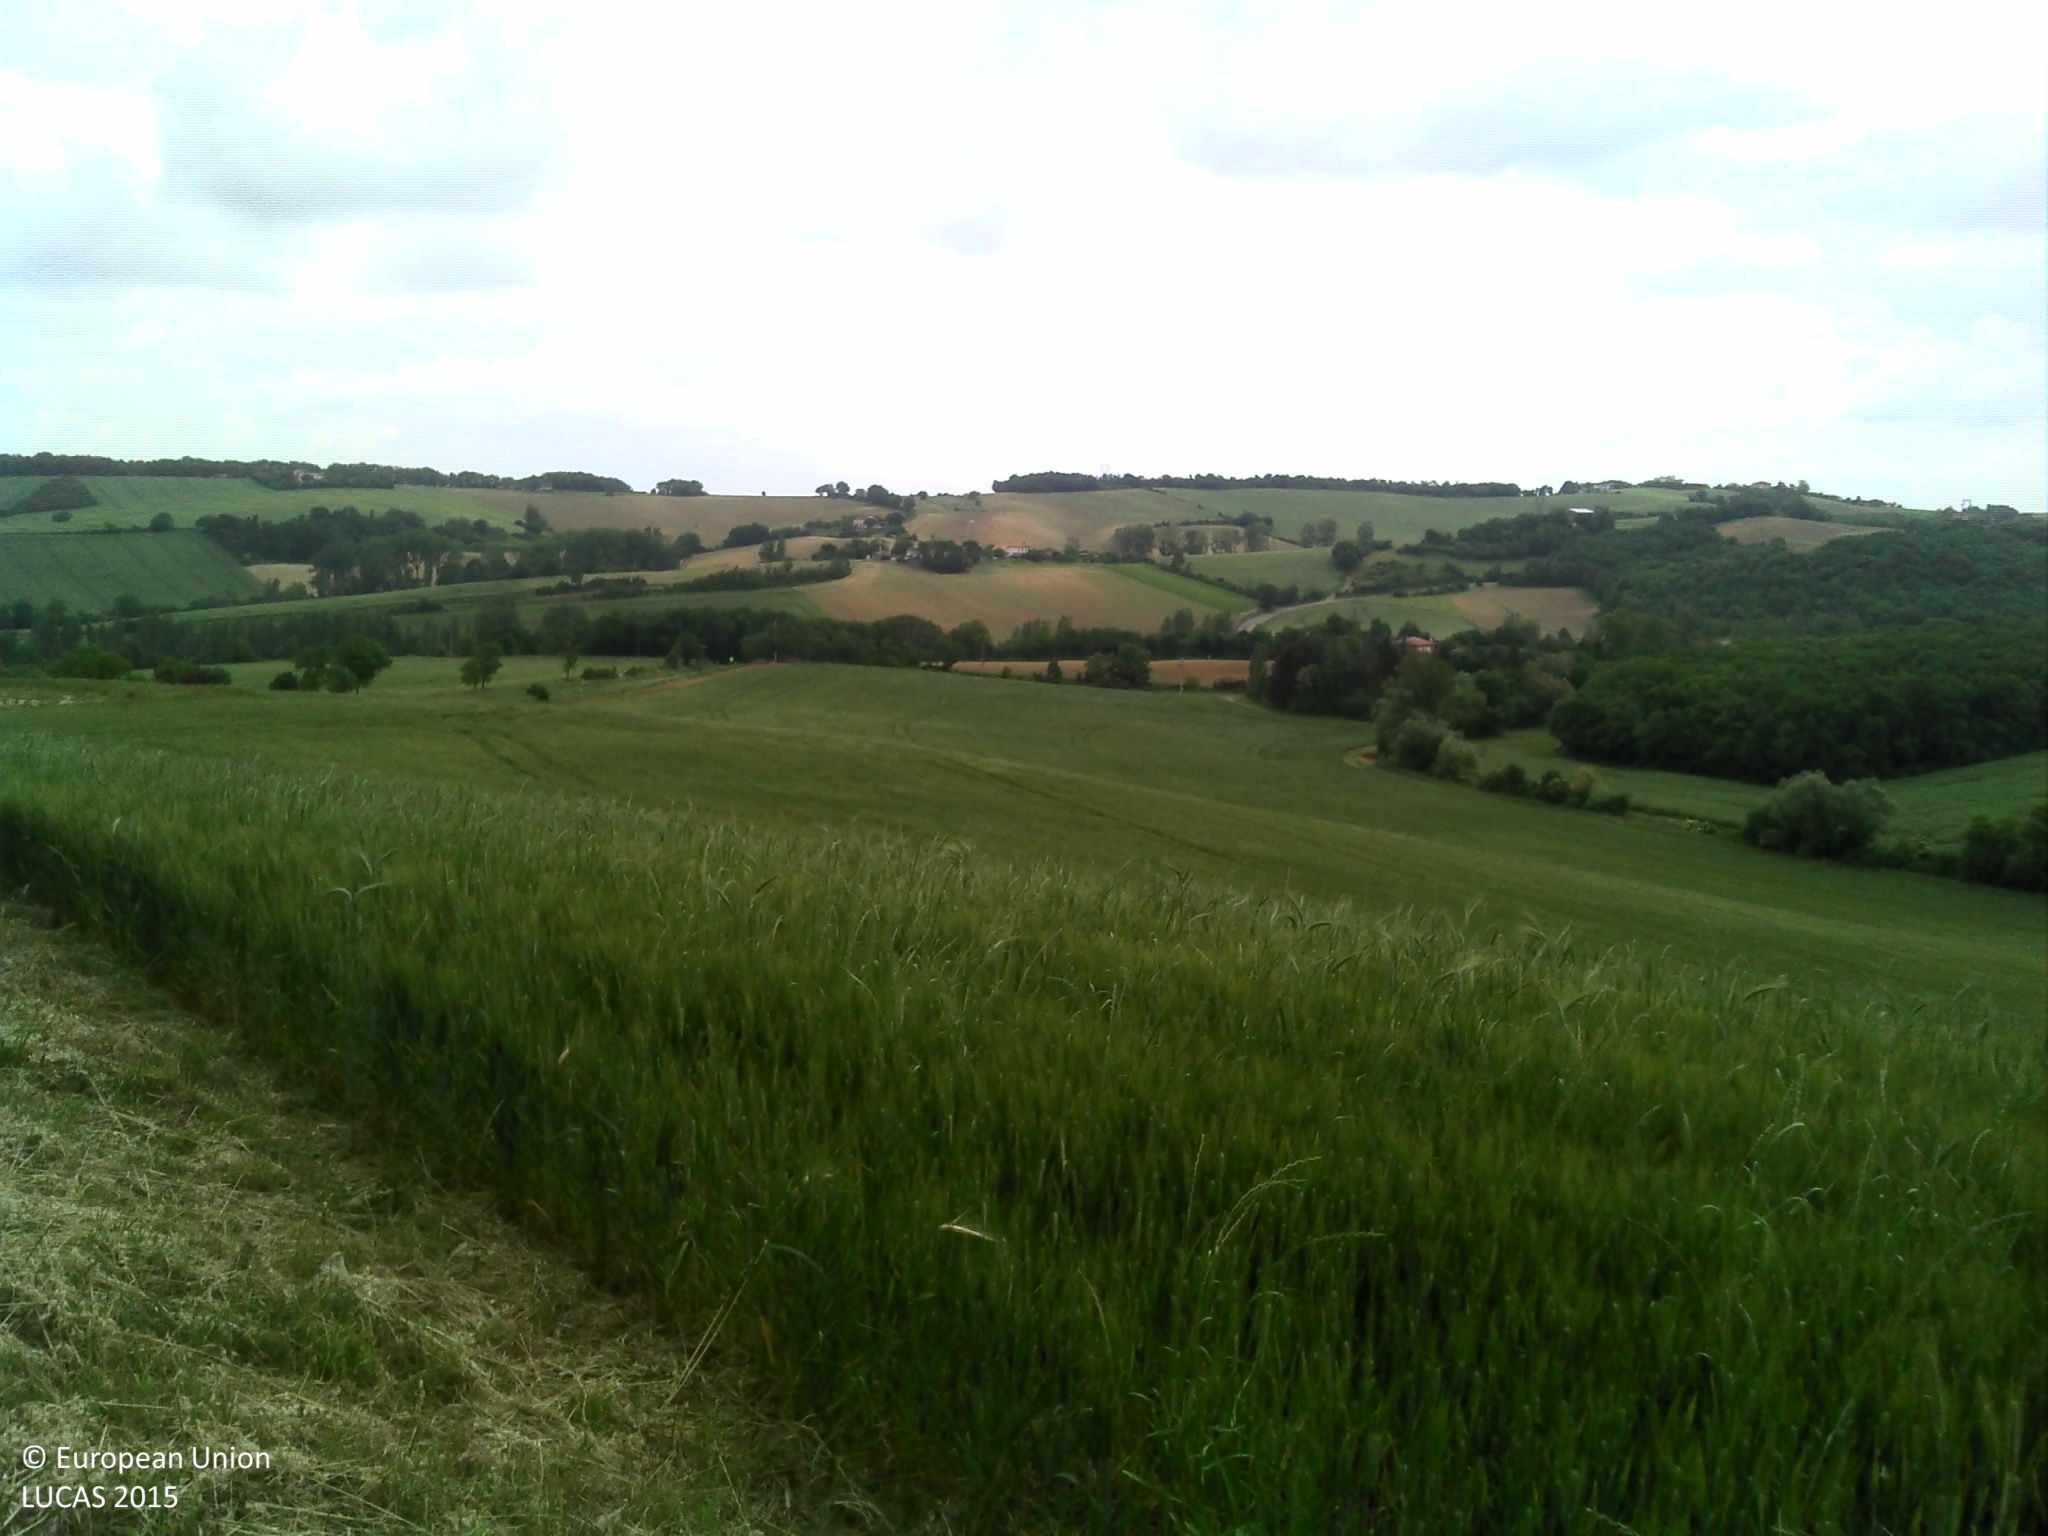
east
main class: Grassland
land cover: Grassland with sparse tree/shrub cover
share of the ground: > 75 %
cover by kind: herbaceous plants 95 %, broadleaved forest trees 5 %
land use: Agriculture (excluding fallow land and kitchen gardens)
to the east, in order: Grassland with sparse tree/shrub cover; Barley
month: May
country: FR
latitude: 43.7115
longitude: 1.7252
